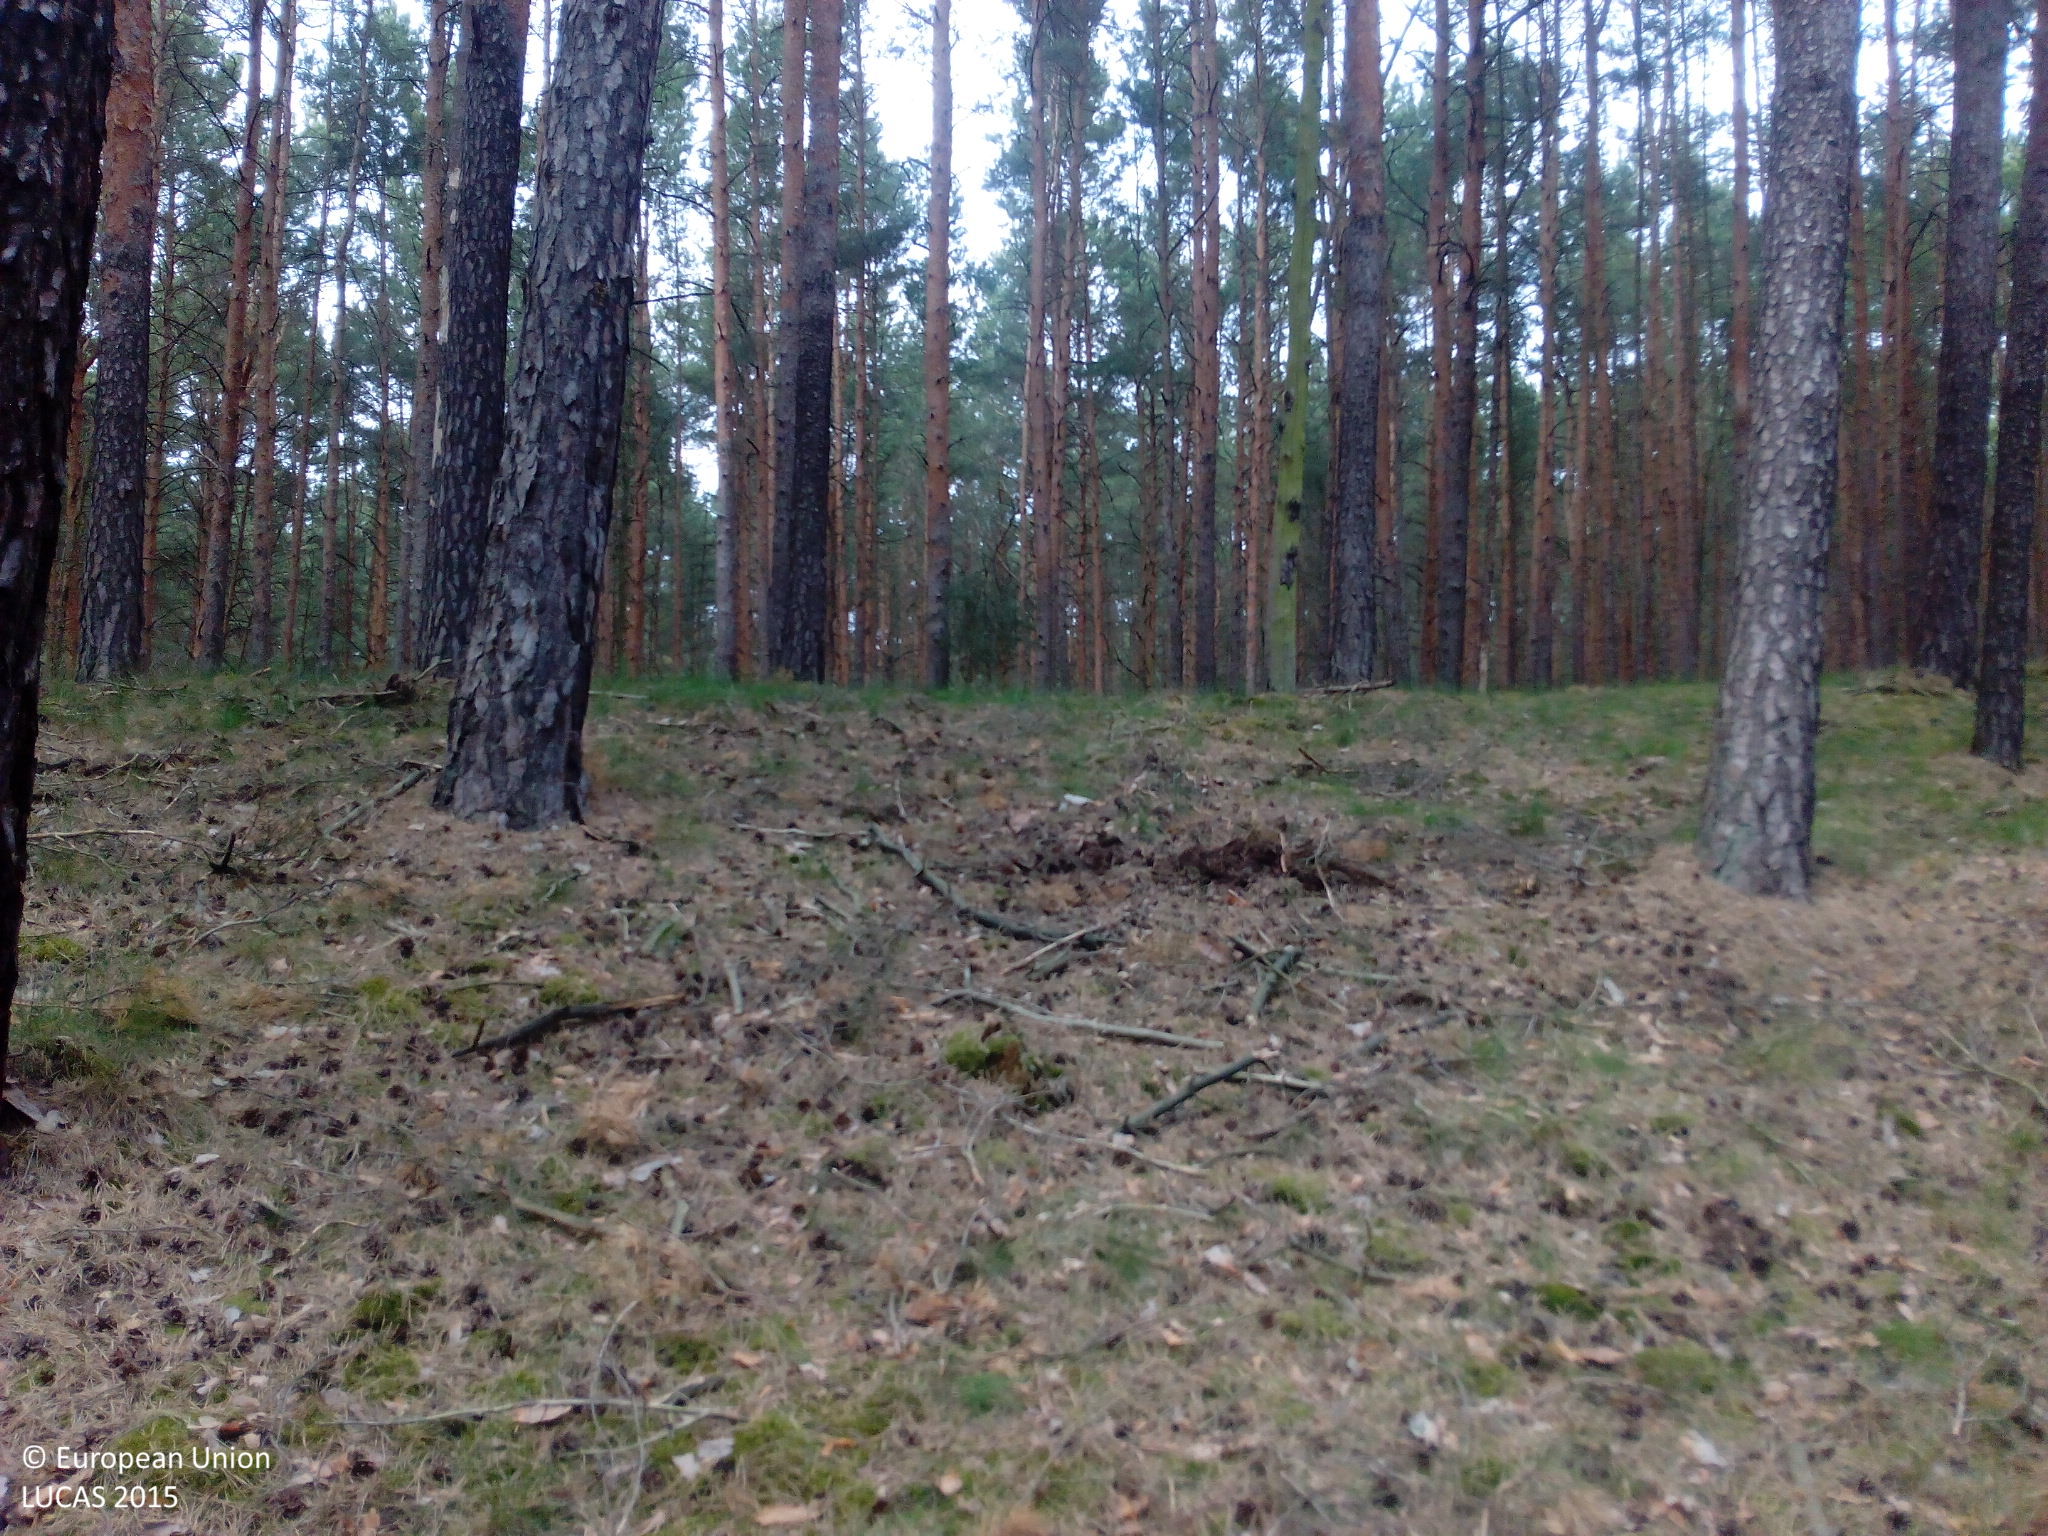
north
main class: Woodland
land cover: Pine dominated coniferous woodland
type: hemiboreal forest and nemoral coniferous forest and mixed broadleaved-coniferous forest
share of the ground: > 75 %
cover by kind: coniferous forest trees 70 %, lichens and mosses 20 %, herbaceous plants 10 %
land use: Forestry
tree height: > 5 m
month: May
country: DE
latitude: 52.2833
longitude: 13.0929
